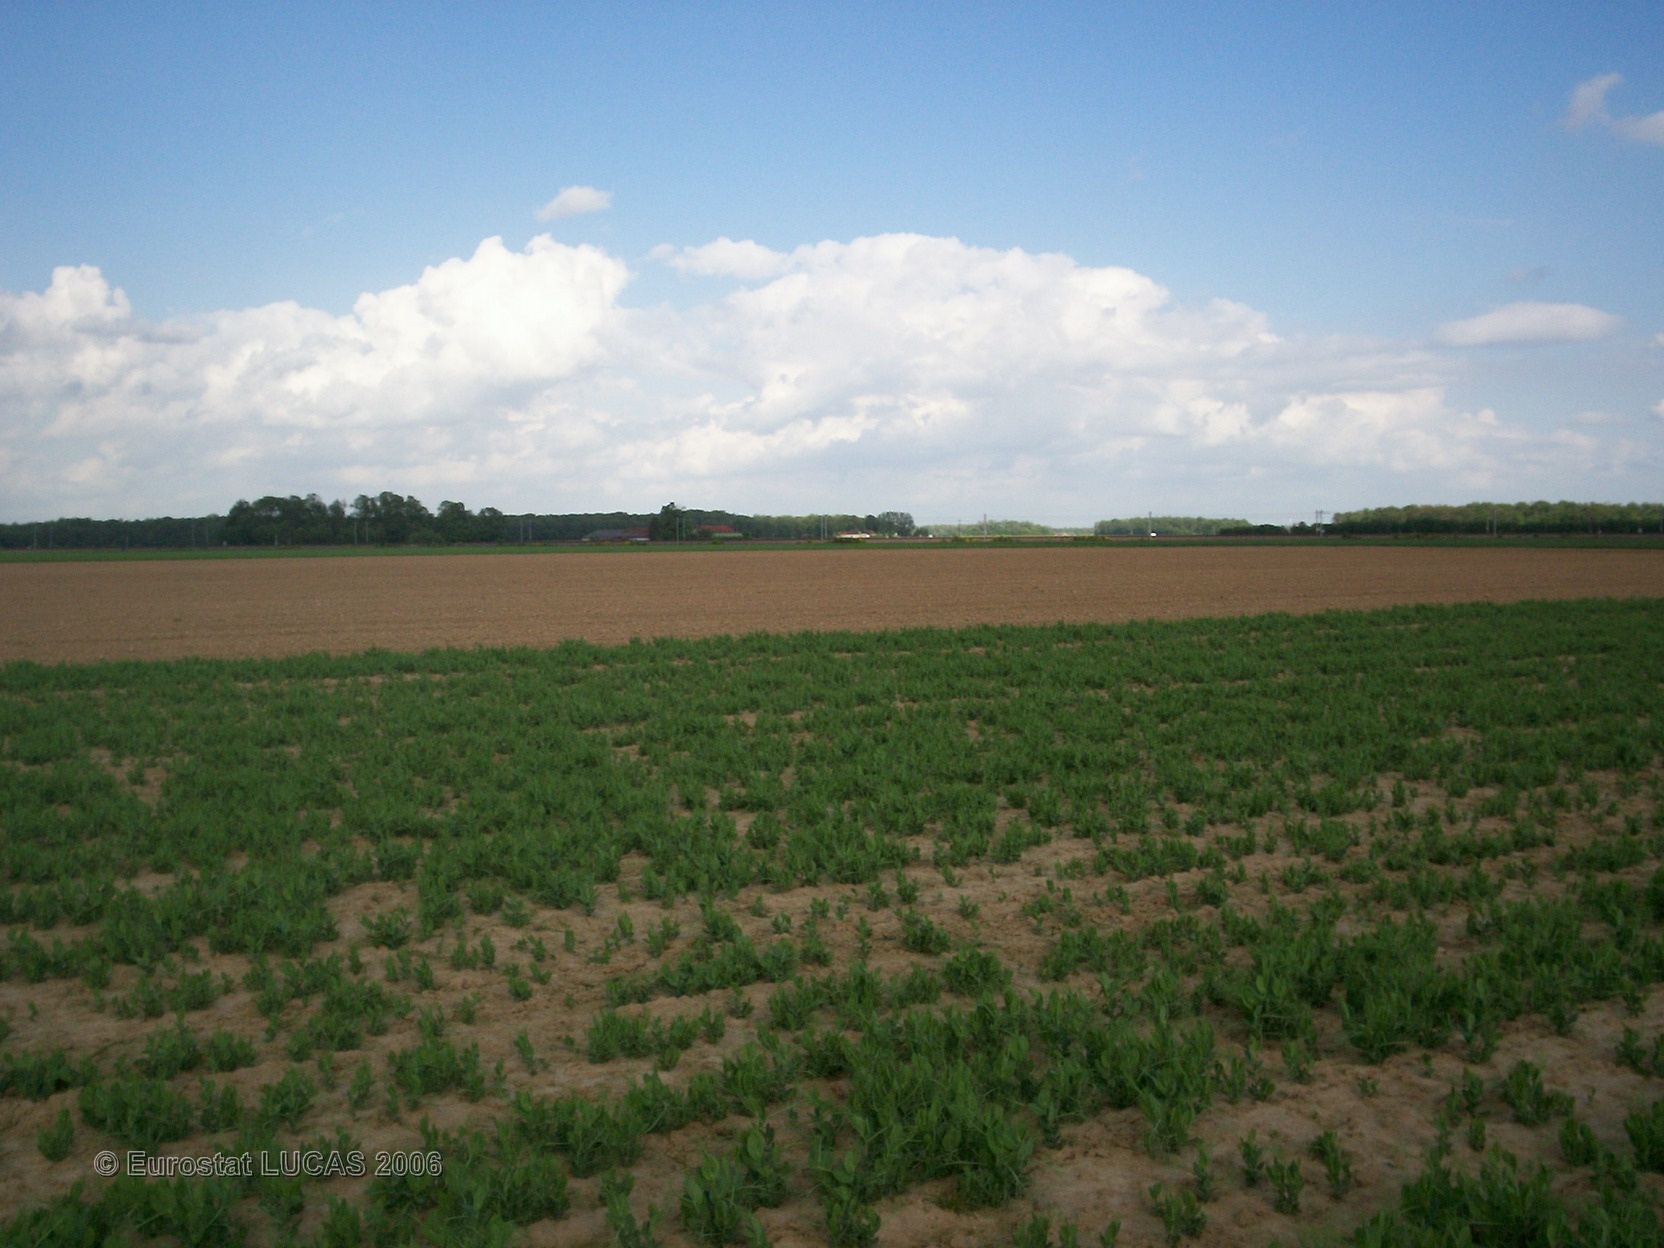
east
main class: Cropland
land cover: Dry pulses
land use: Agriculture (excluding fallow land and kitchen gardens)
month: May
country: FR
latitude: 48.7464
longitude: 2.7962
